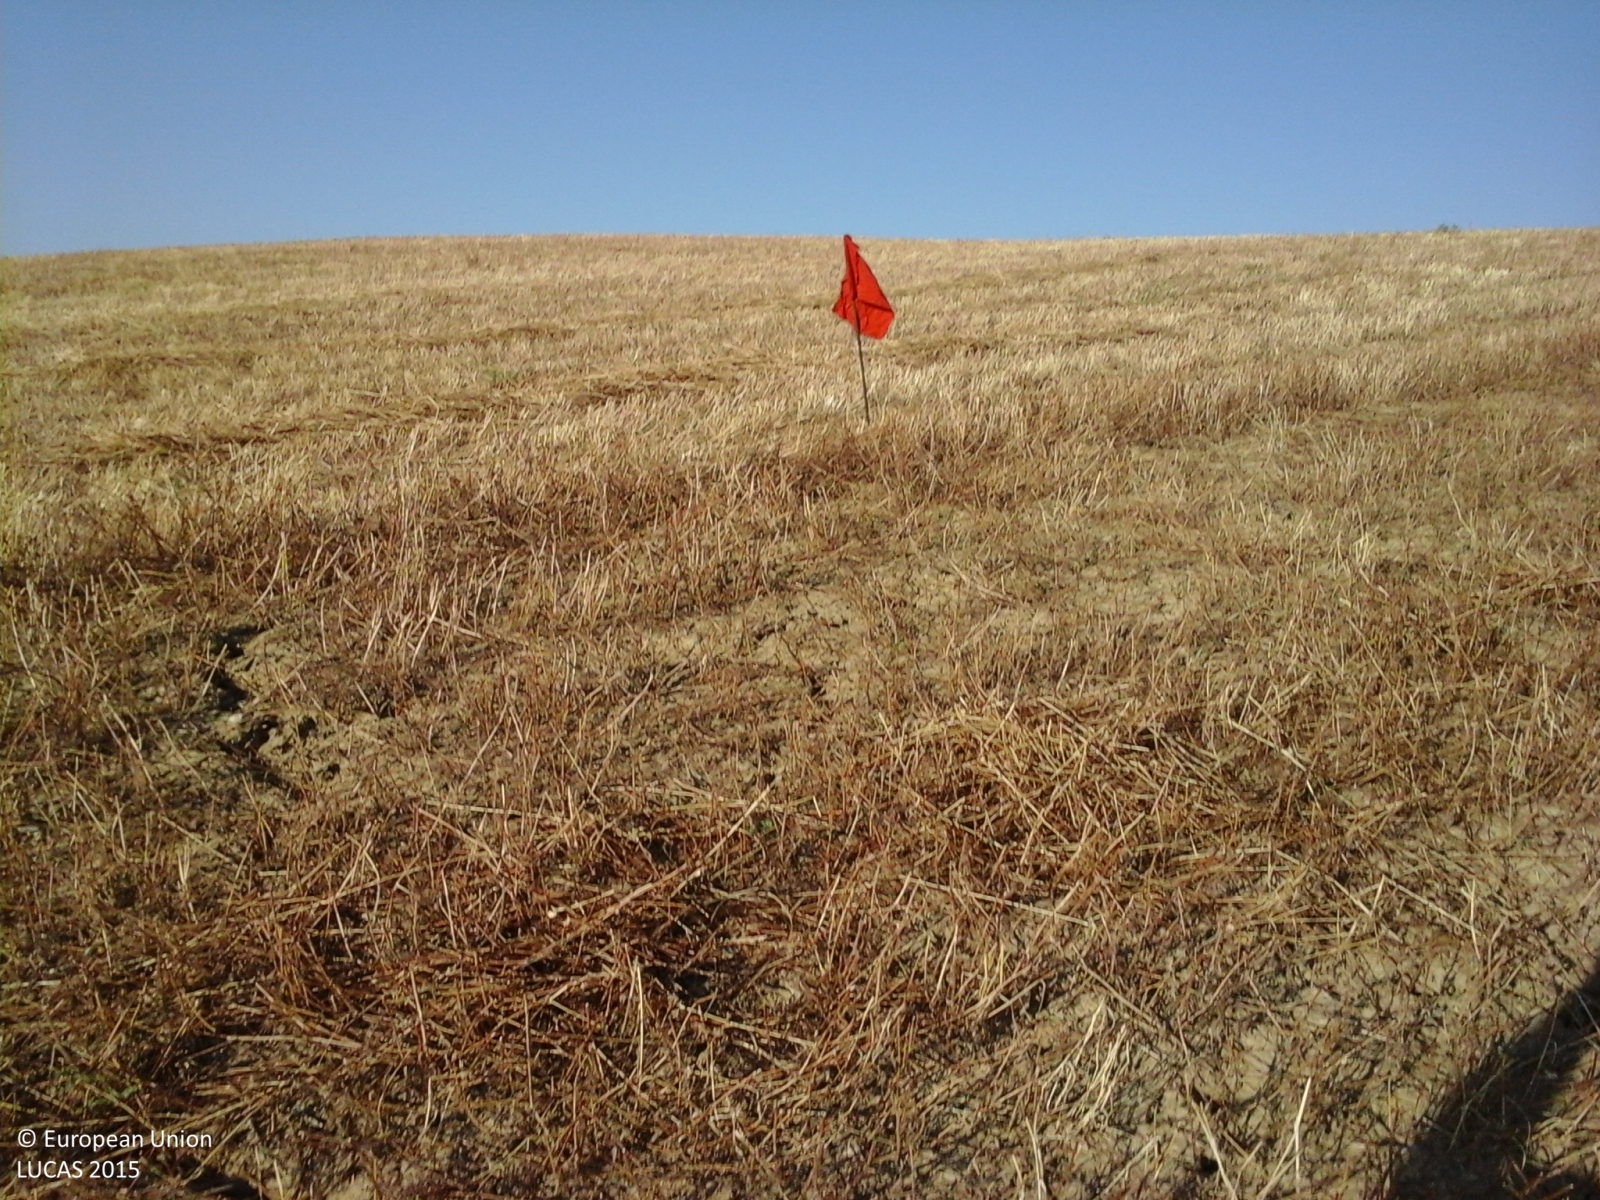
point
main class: Cropland
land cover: Lucerne
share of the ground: > 75 %
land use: Agriculture (excluding fallow land and kitchen gardens)
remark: Harvested field
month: August
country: IT
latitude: 42.9838
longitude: 11.6505
